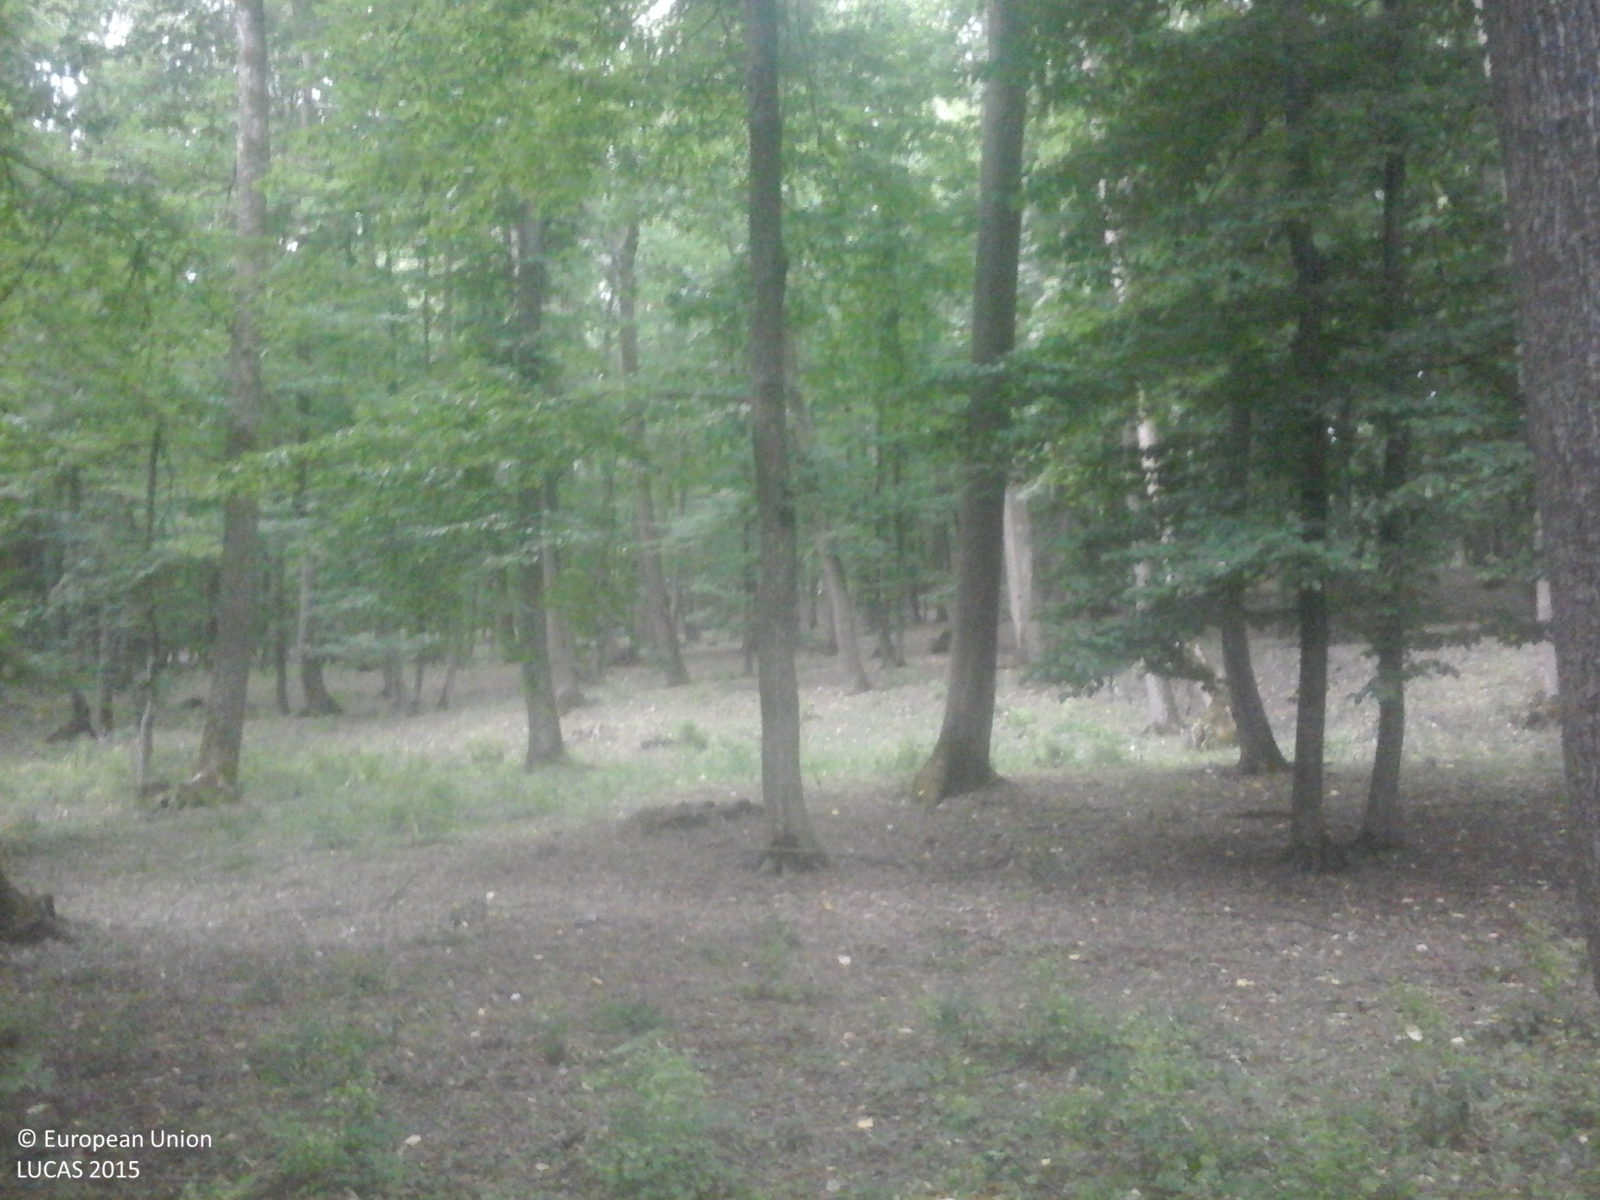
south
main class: Woodland
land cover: Broadleaved woodland
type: beech forest
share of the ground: > 75 %
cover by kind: broadleaved forest trees 95 %, herbaceous plants 5 %
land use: Forestry
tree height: > 5 m
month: June
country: RO
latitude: 47.6382
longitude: 26.8025
